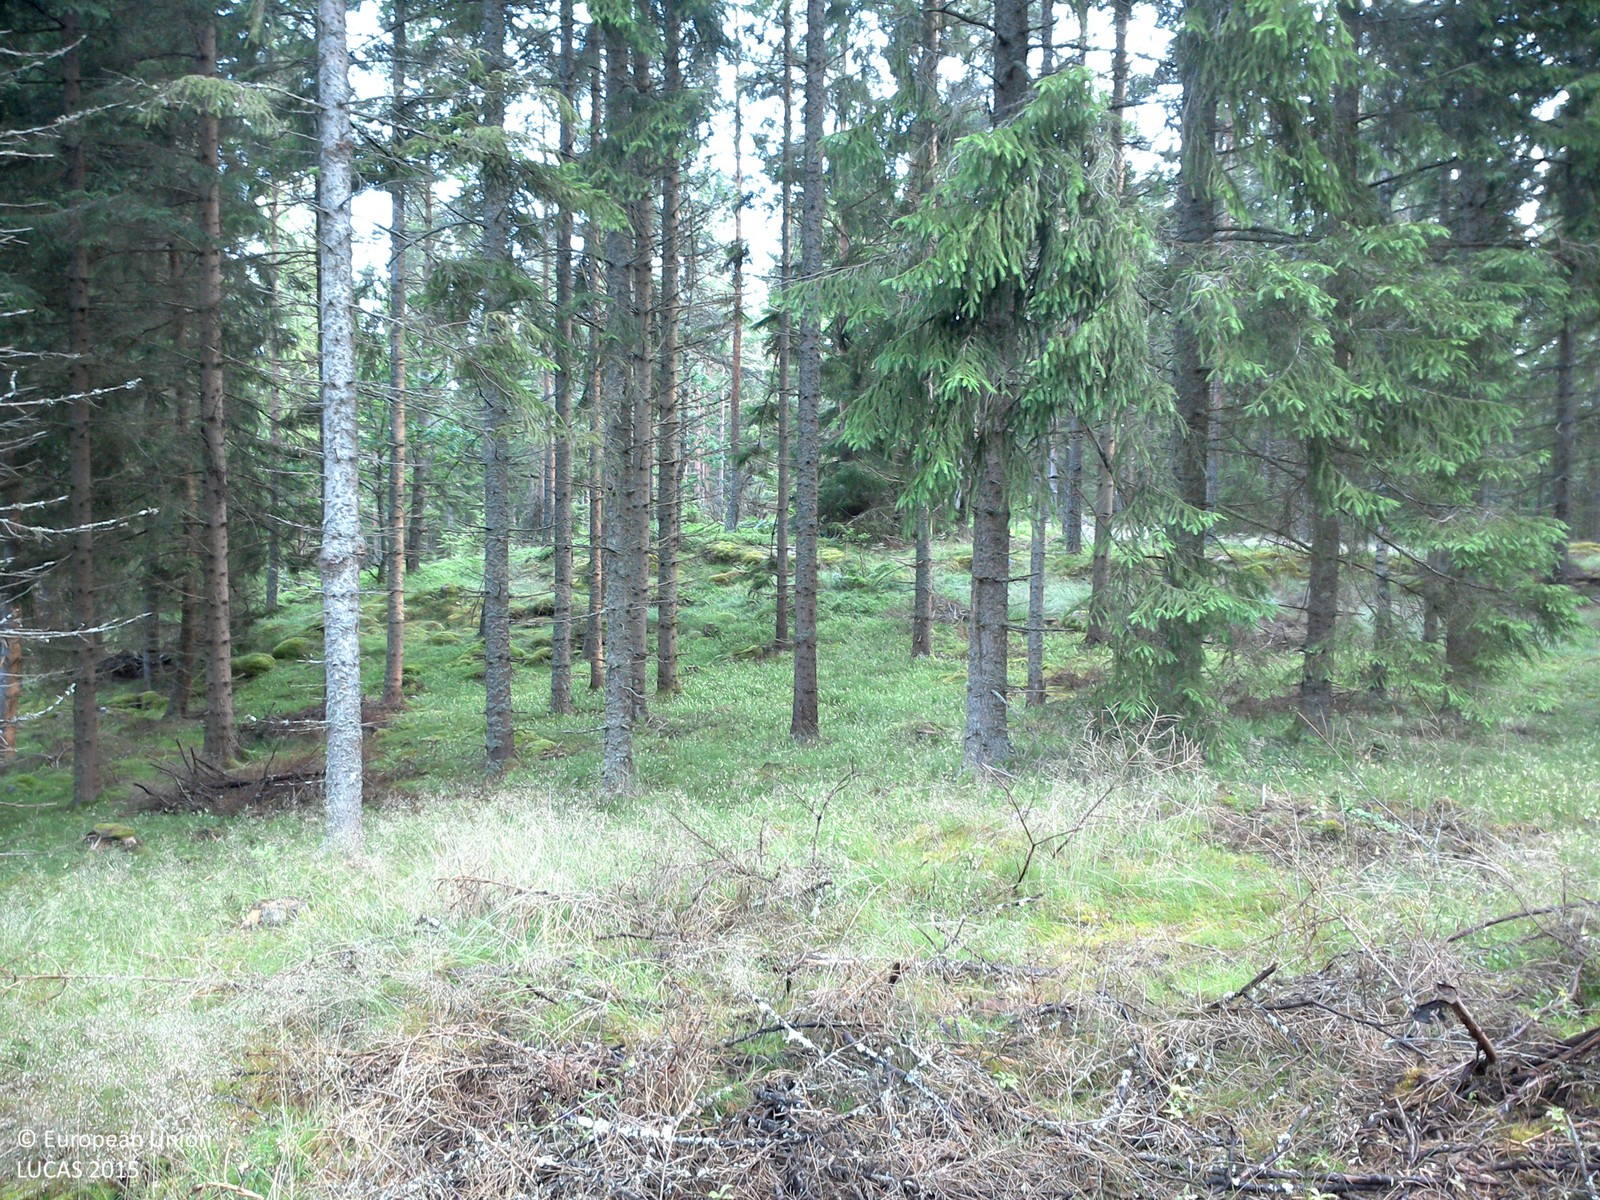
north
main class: Woodland
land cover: Pine dominated coniferous woodland
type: boreal forest
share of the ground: 25 - 50 %
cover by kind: coniferous forest trees 45 %, herbaceous plants 35 %, lichens and mosses 20 %
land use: Forestry
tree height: > 5 m
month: July
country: SE
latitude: 58.2711
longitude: 14.9894
